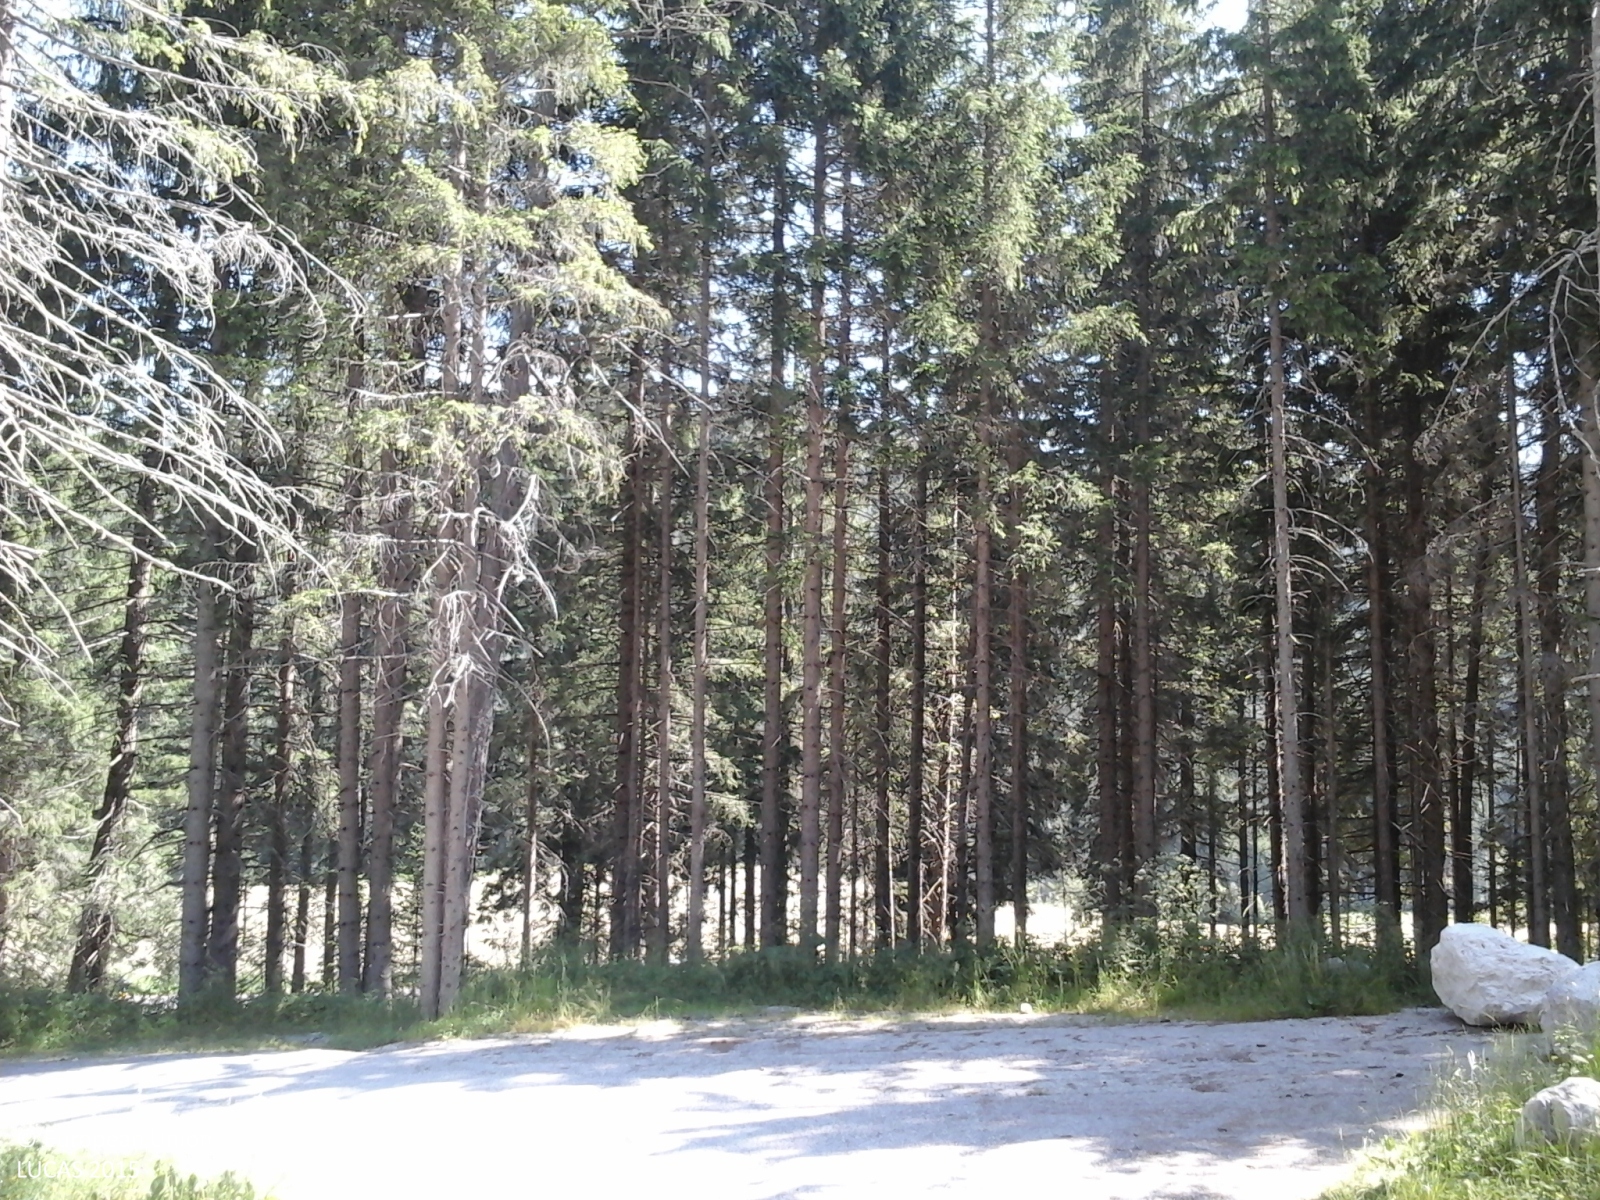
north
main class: Woodland
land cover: Spruce dominated coniferous woodland
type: alpine coniferous forest
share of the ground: > 75 %
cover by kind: coniferous forest trees 100 %
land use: Forestry
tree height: > 5 m
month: July
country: IT
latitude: 46.6866
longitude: 12.3119
